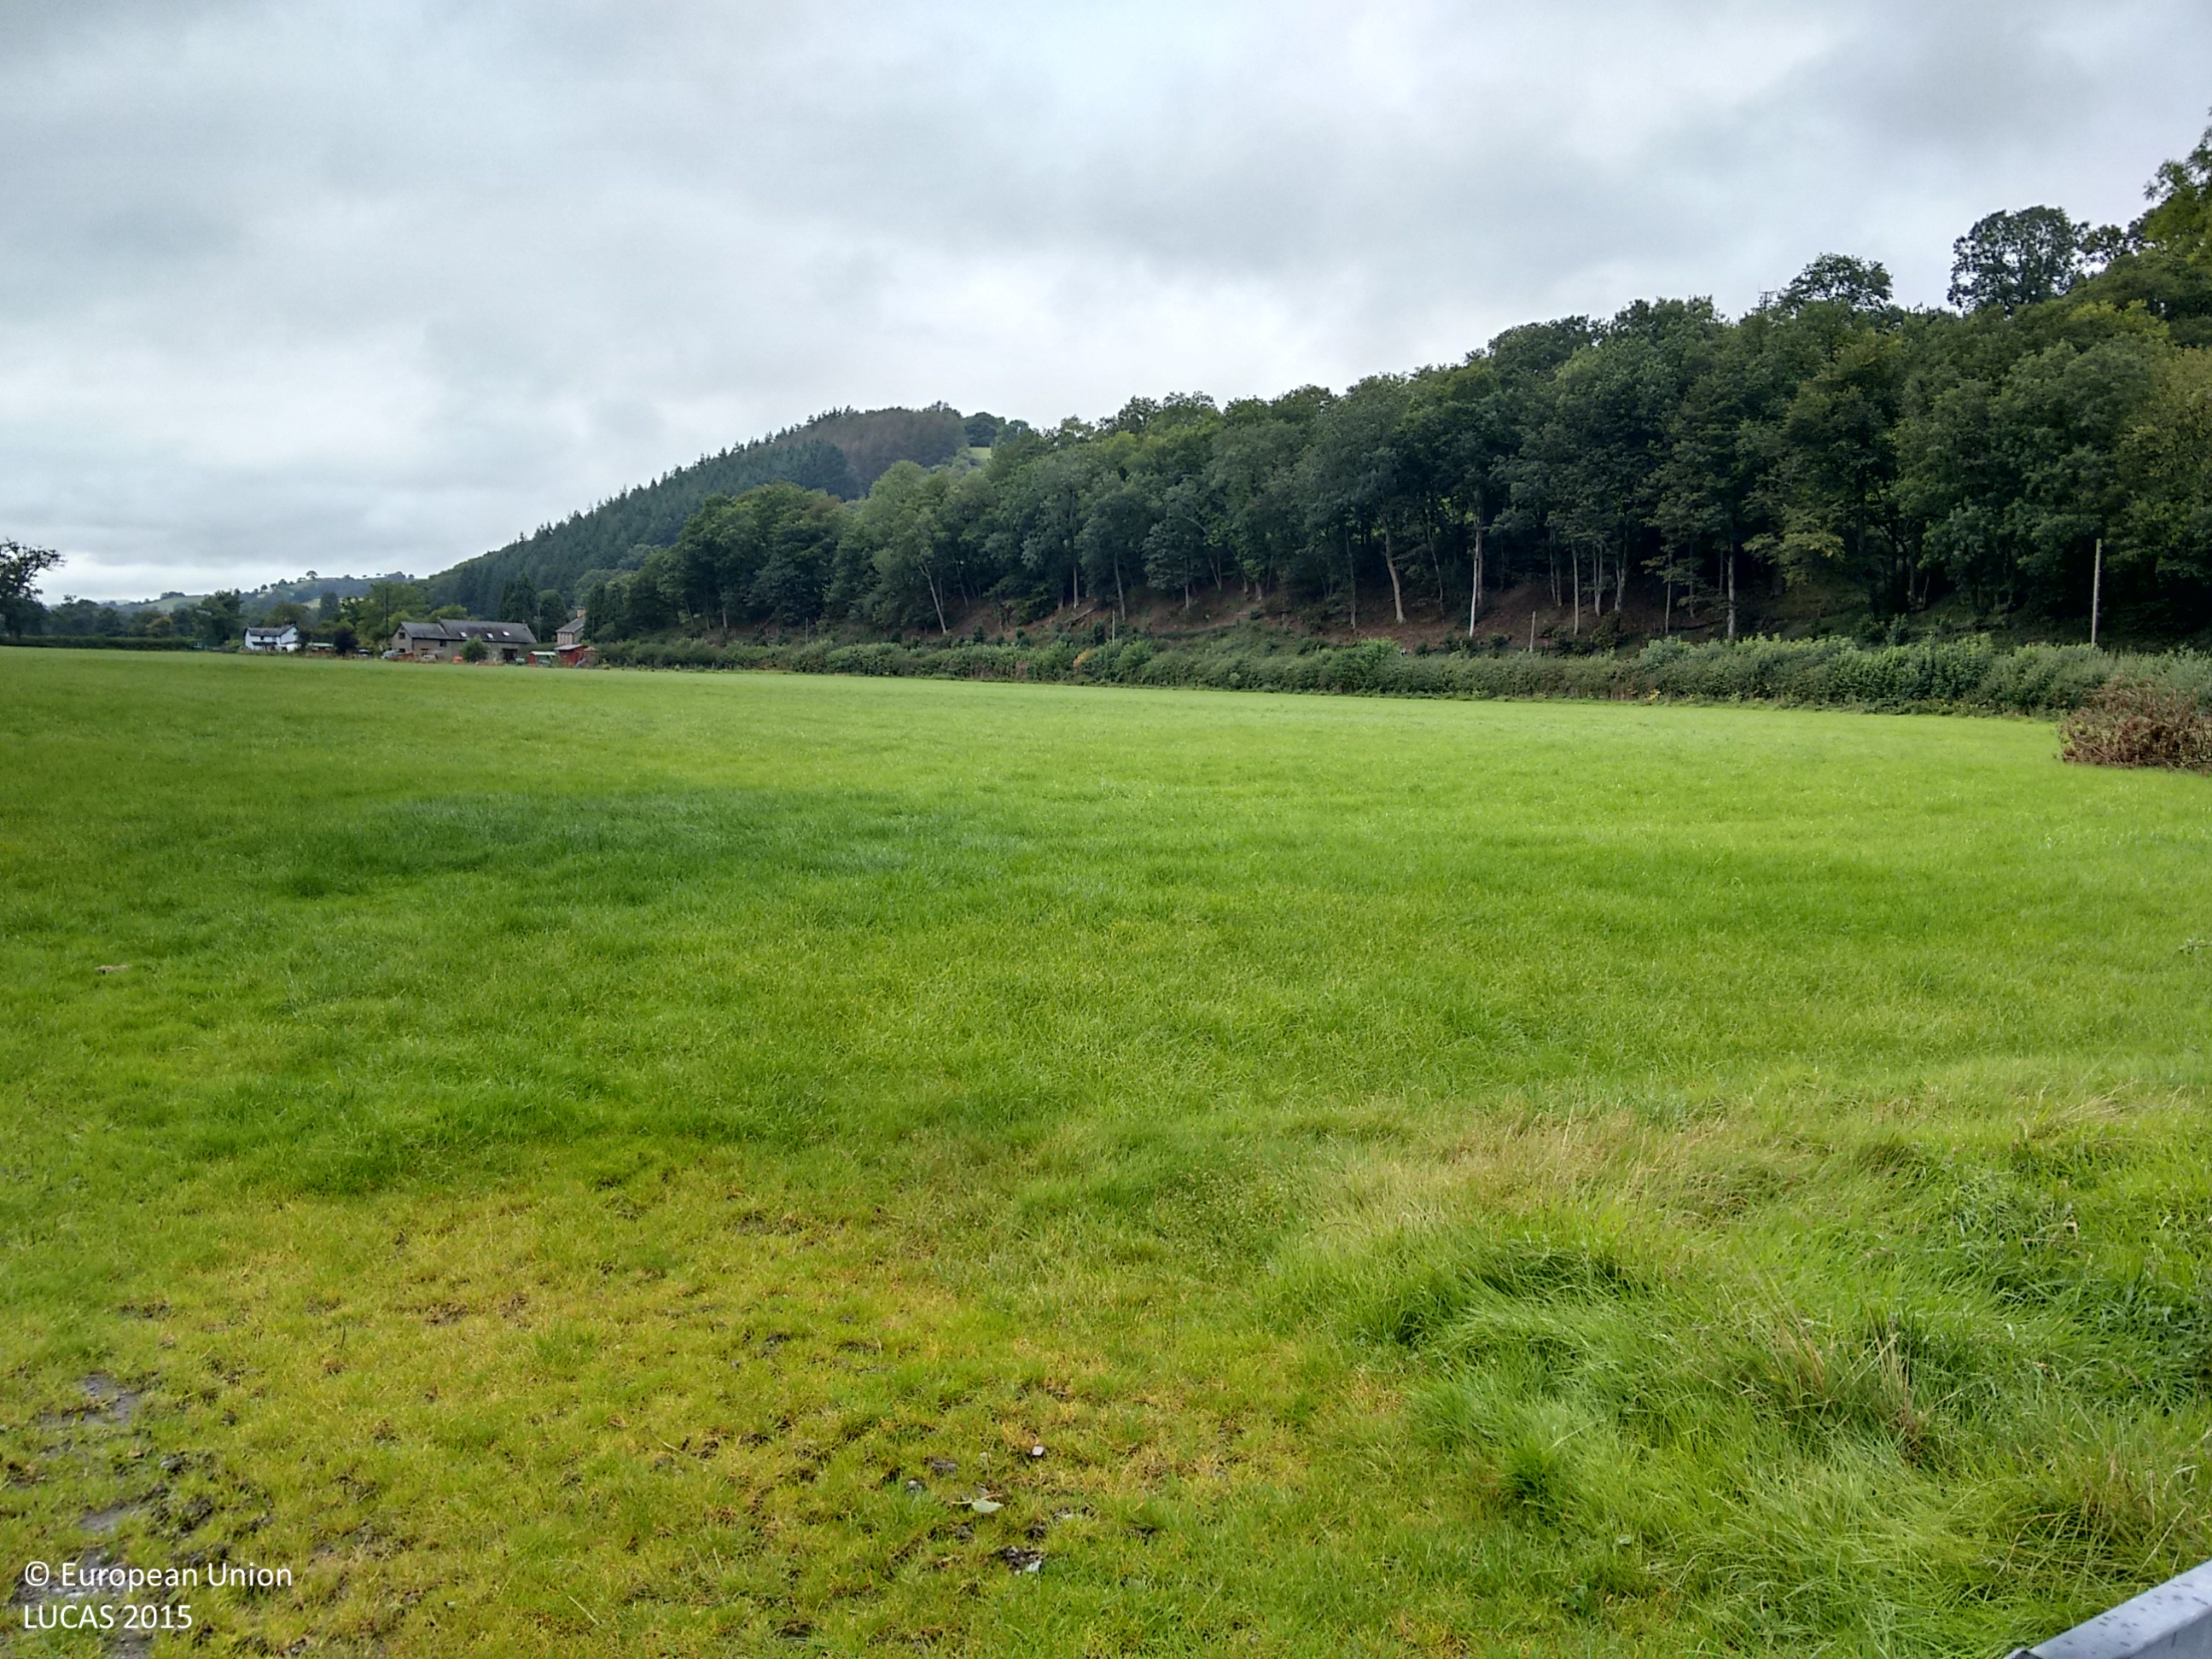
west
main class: Grassland
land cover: Grassland without tree/shrub cover
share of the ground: > 75 %
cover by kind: herbaceous plants 100 %
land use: Agriculture (excluding fallow land and kitchen gardens)
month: September
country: GB
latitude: 51.9836
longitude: -3.8214
